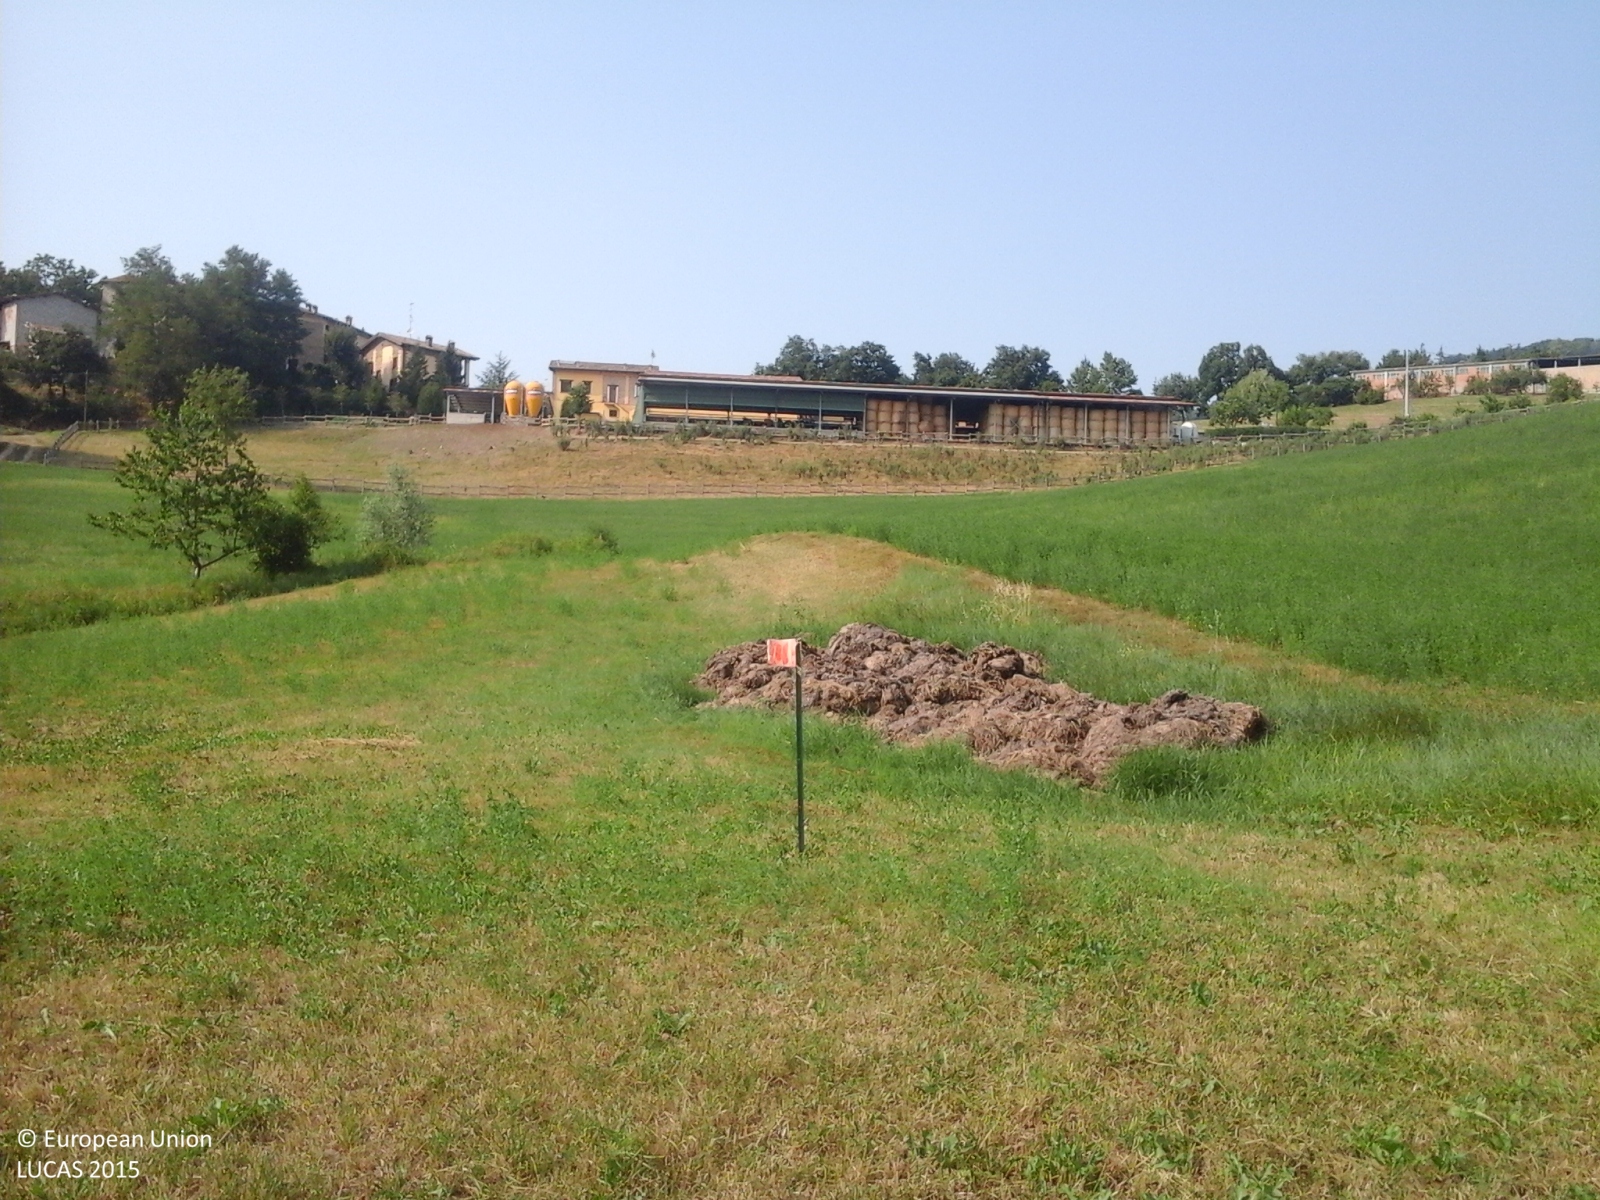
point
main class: Cropland
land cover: Lucerne
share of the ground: > 75 %
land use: Agriculture (excluding fallow land and kitchen gardens)
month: July
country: IT
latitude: 44.4210
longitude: 10.5890
